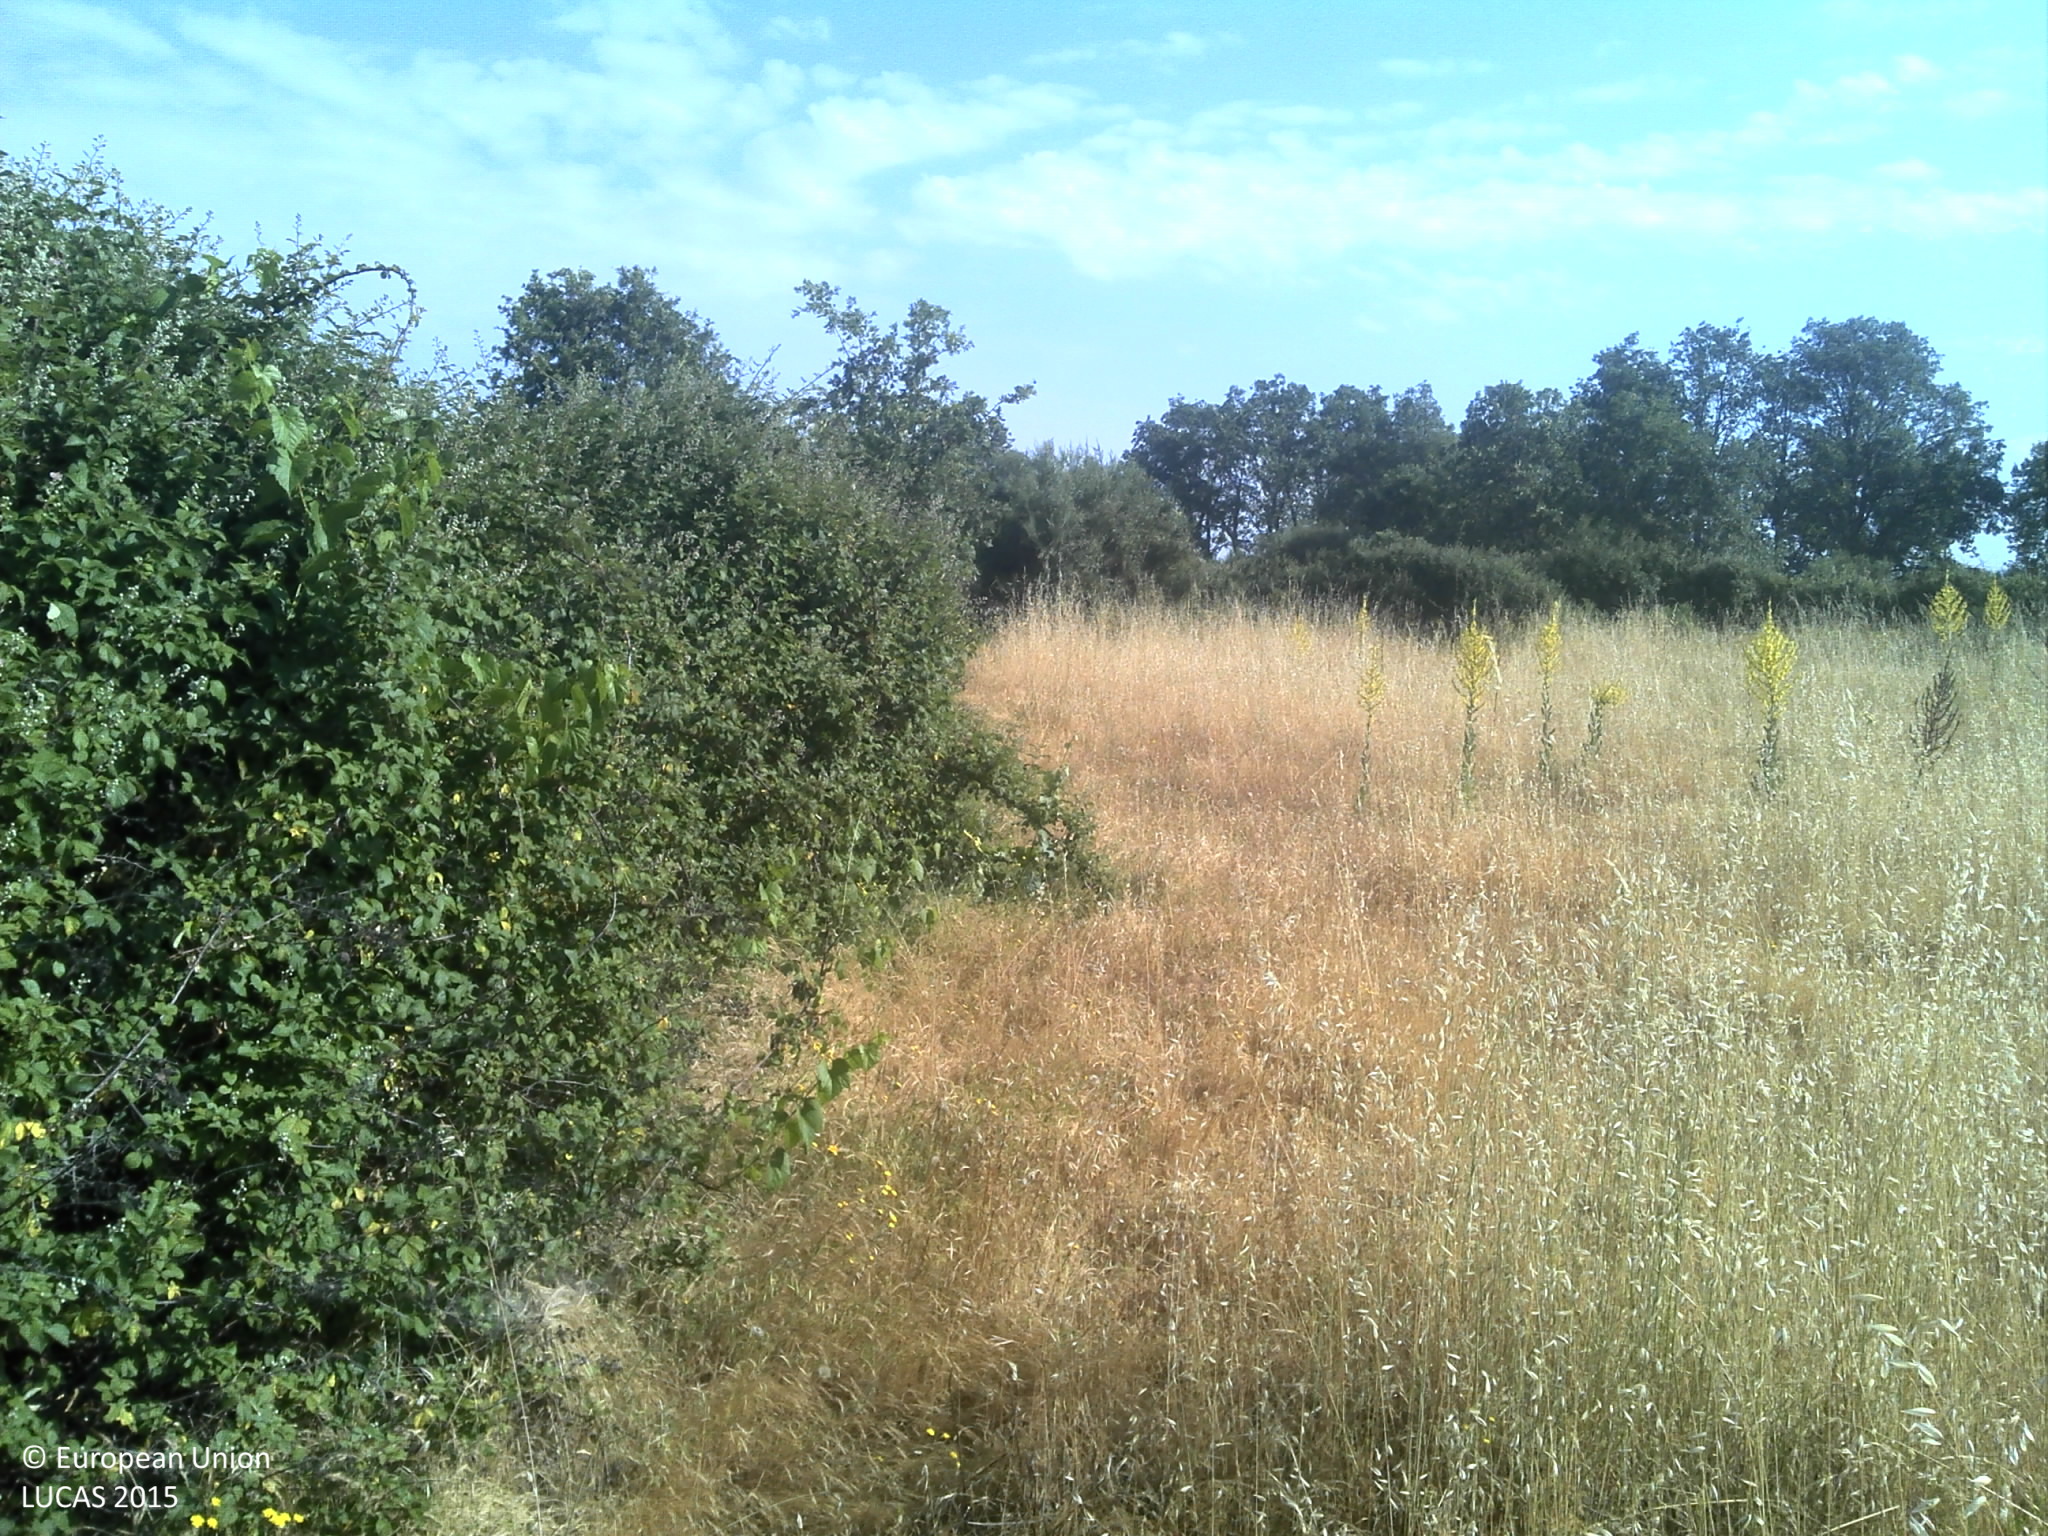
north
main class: Shrubland
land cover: Shrubland with sparse tree cover
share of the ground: > 75 %
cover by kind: shrubs 85 %, broadleaved forest trees 5 %, unconsolidated bare surface 5 %
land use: Abandoned areas
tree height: < 5 m
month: June
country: PT
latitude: 40.3581
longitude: -6.9935
